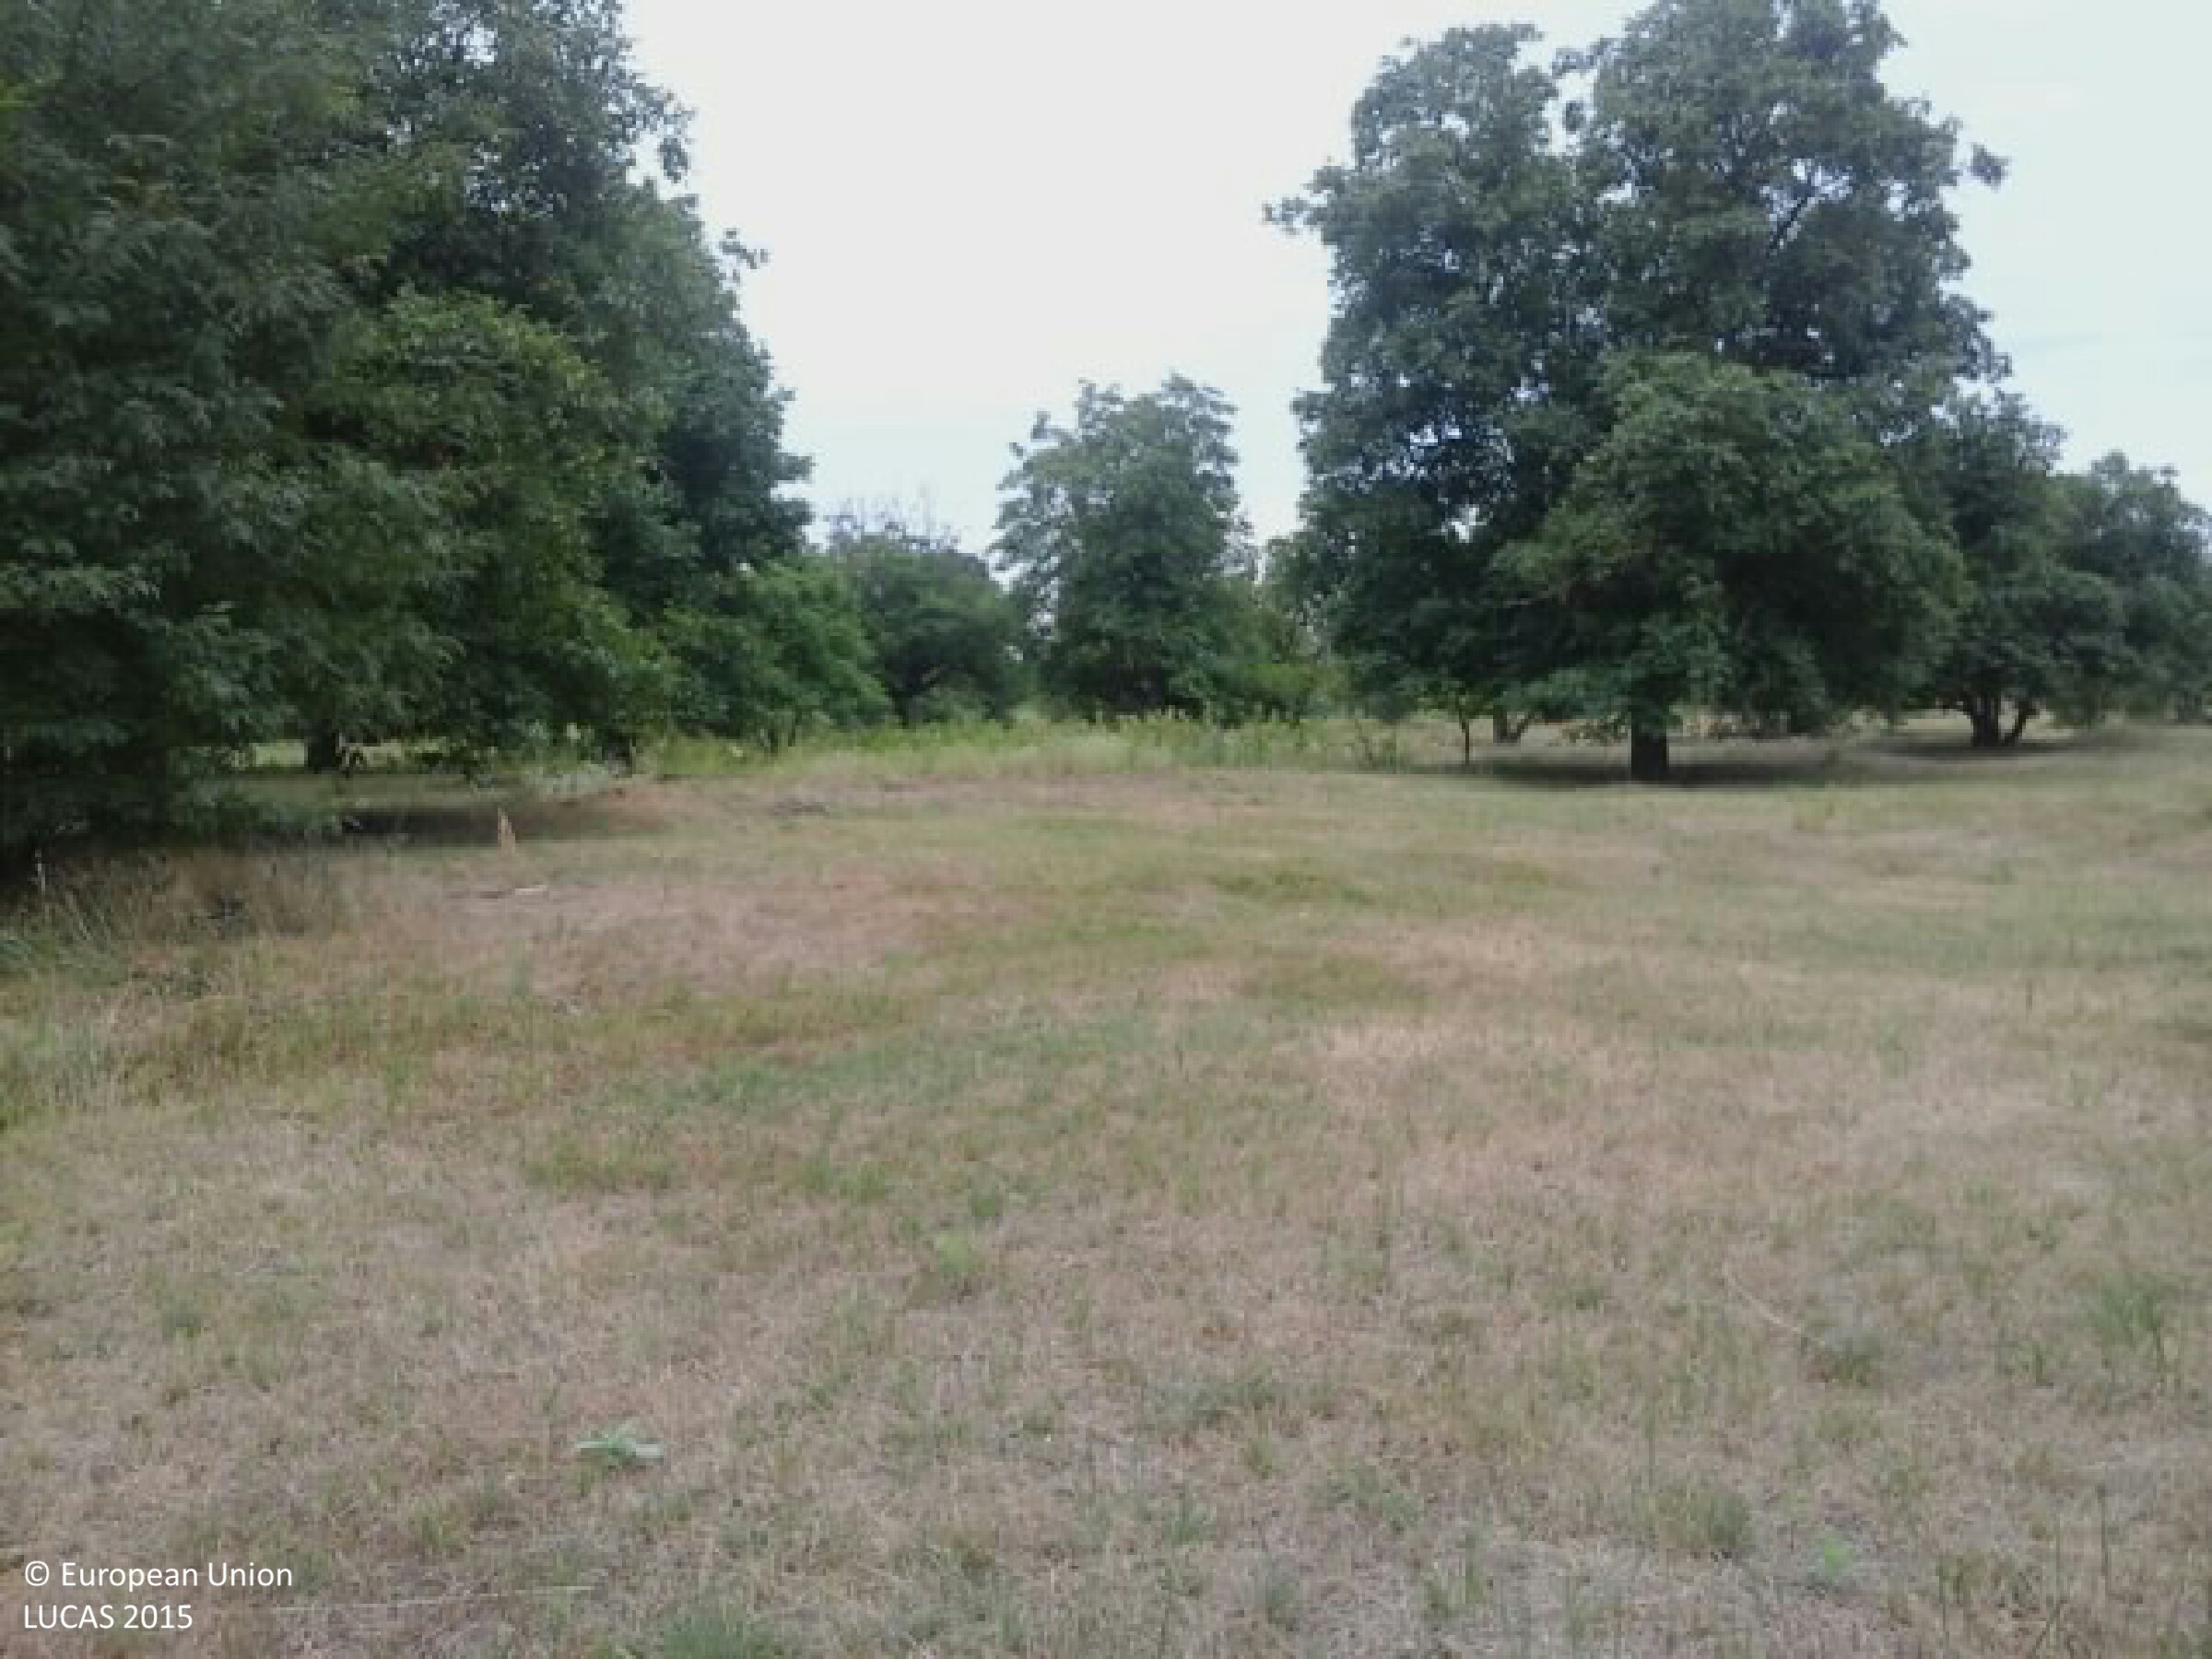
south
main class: Grassland
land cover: Grassland with sparse tree/shrub cover
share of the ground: > 75 %
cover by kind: herbaceous plants 90 %, broadleaved forest trees 5 %, shrubs 5 %
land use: Agriculture (excluding fallow land and kitchen gardens)
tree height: < 5 m
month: July
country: HU
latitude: 47.1138
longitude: 19.8148
